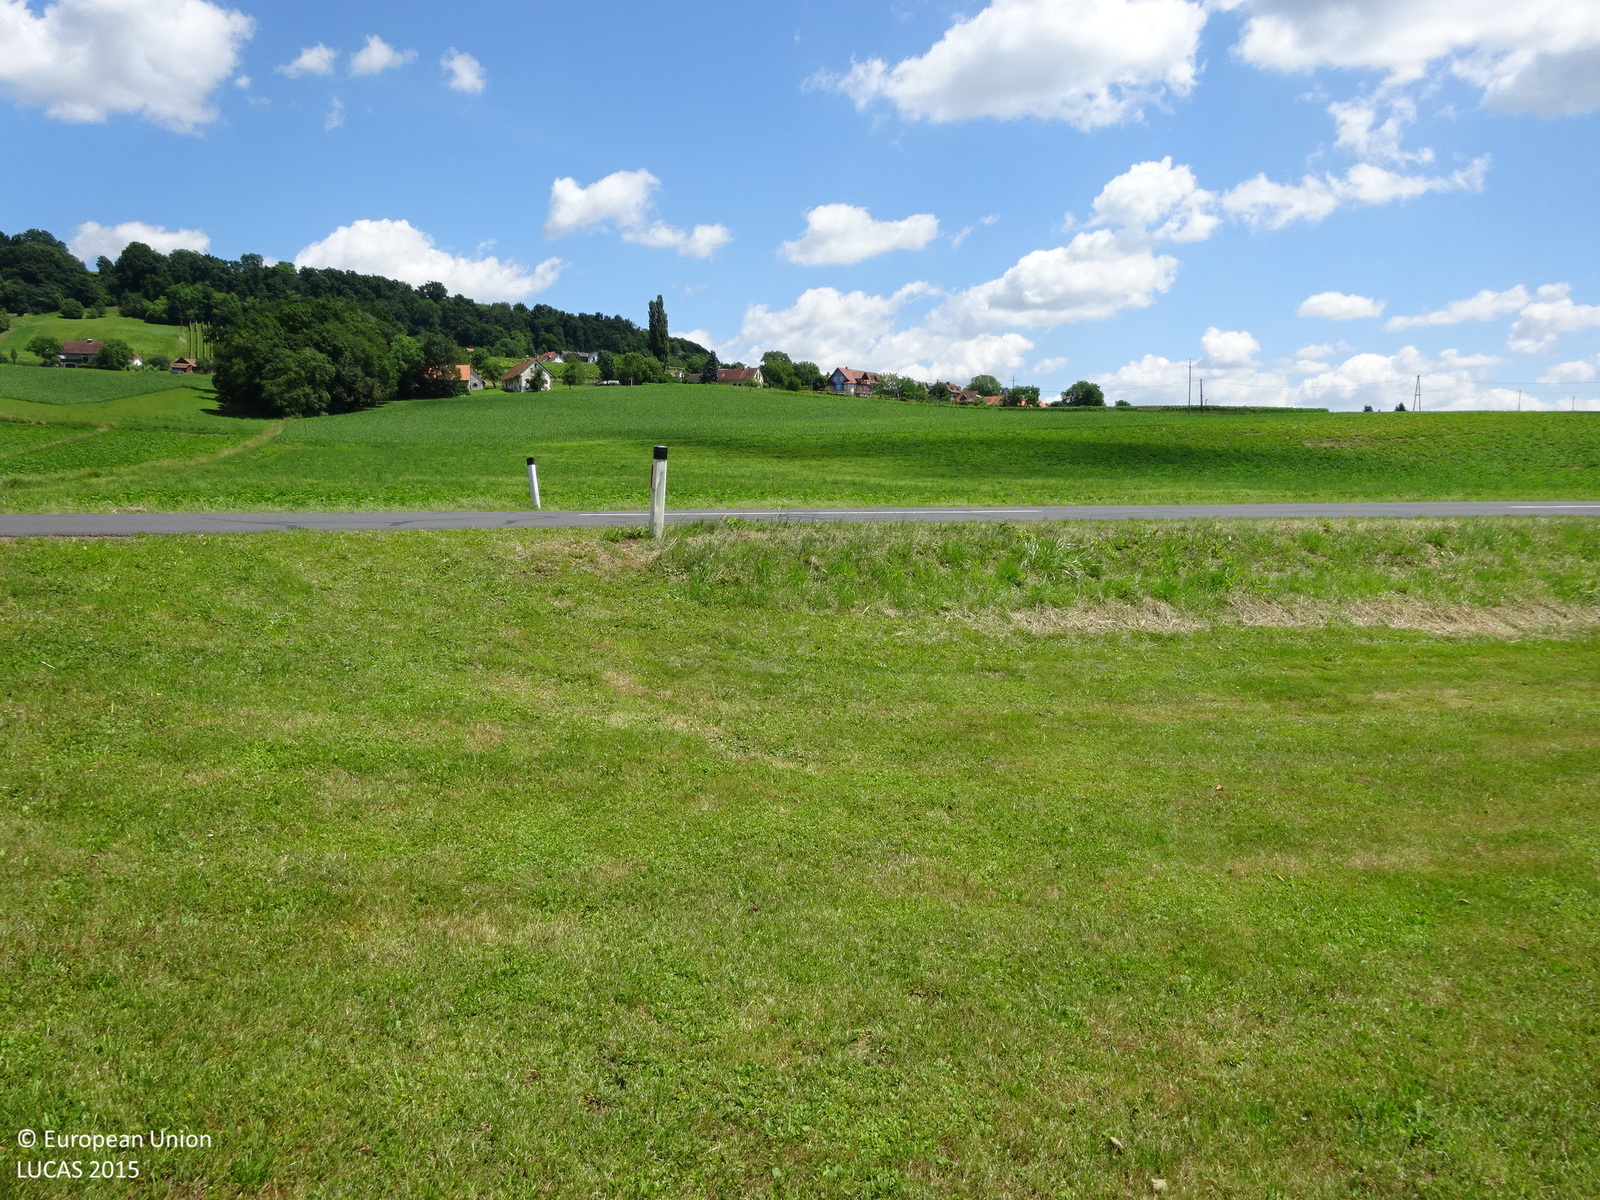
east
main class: Grassland
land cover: Grassland without tree/shrub cover
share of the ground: > 75 %
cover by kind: herbaceous plants 100 %
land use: Agriculture (excluding fallow land and kitchen gardens)
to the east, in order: Grassland without tree/shrub cover; Paved roads, cycling and walking lanes; Grass margins; Ditches and canals; Grassland without tree/shrub cover; Other fibre and oleaginous crops; Maize
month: June
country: AT
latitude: 46.7644
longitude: 15.9317
